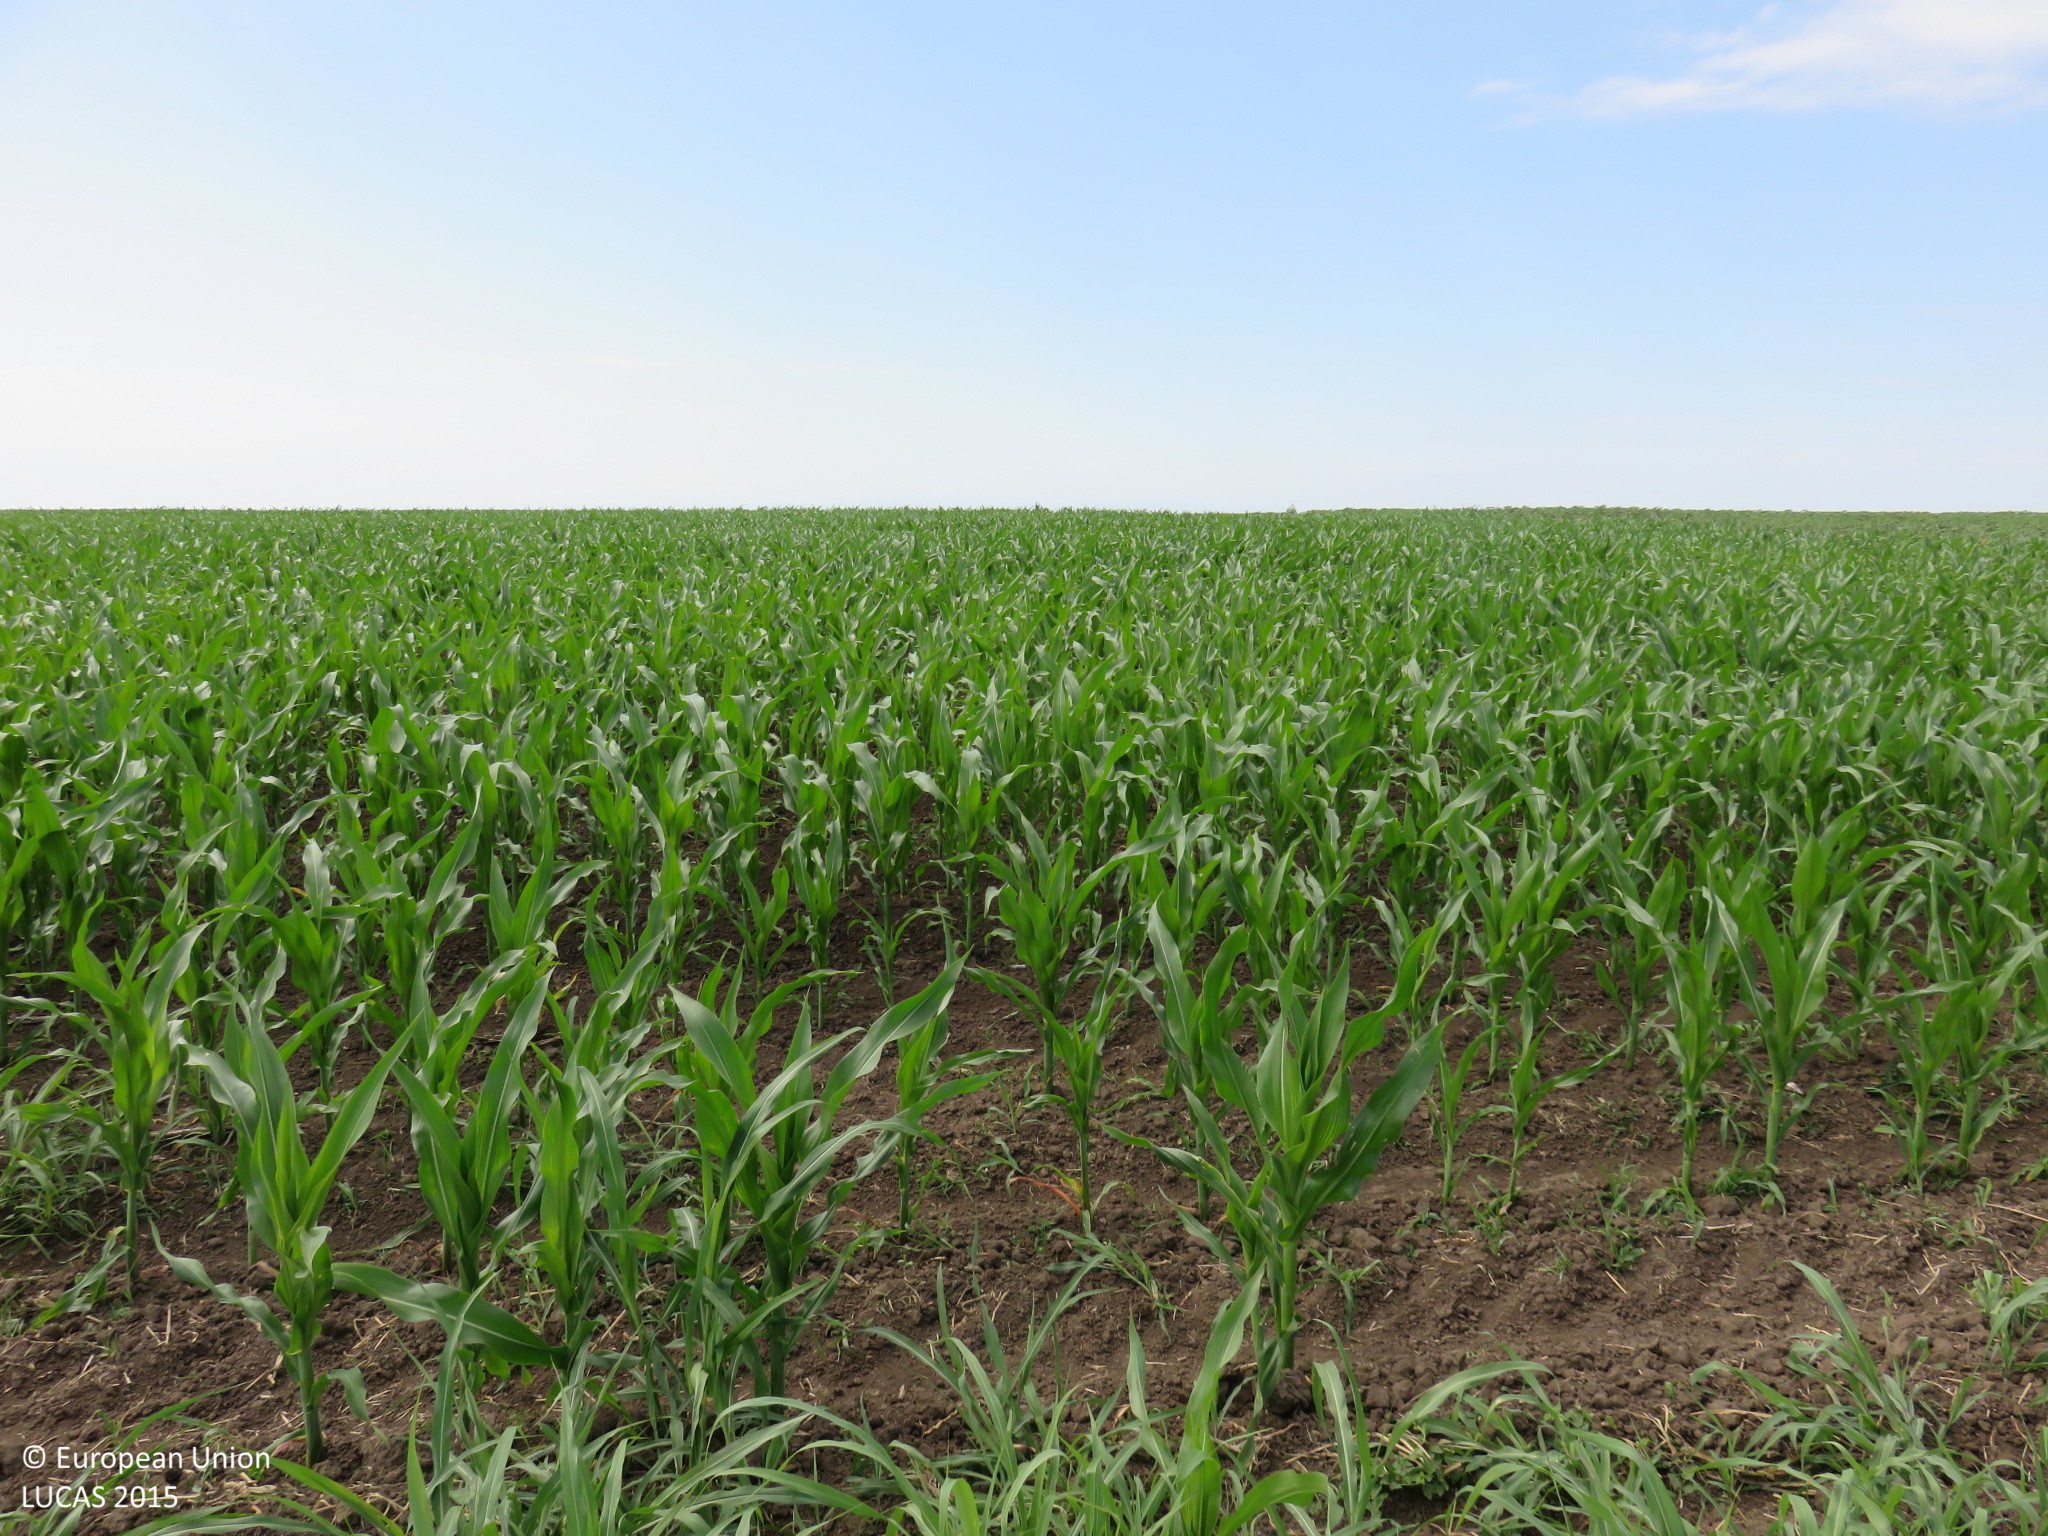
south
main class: Cropland
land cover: Sunflower
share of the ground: > 75 %
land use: Agriculture (excluding fallow land and kitchen gardens)
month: June
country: BG
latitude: 43.5373
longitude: 24.4282
